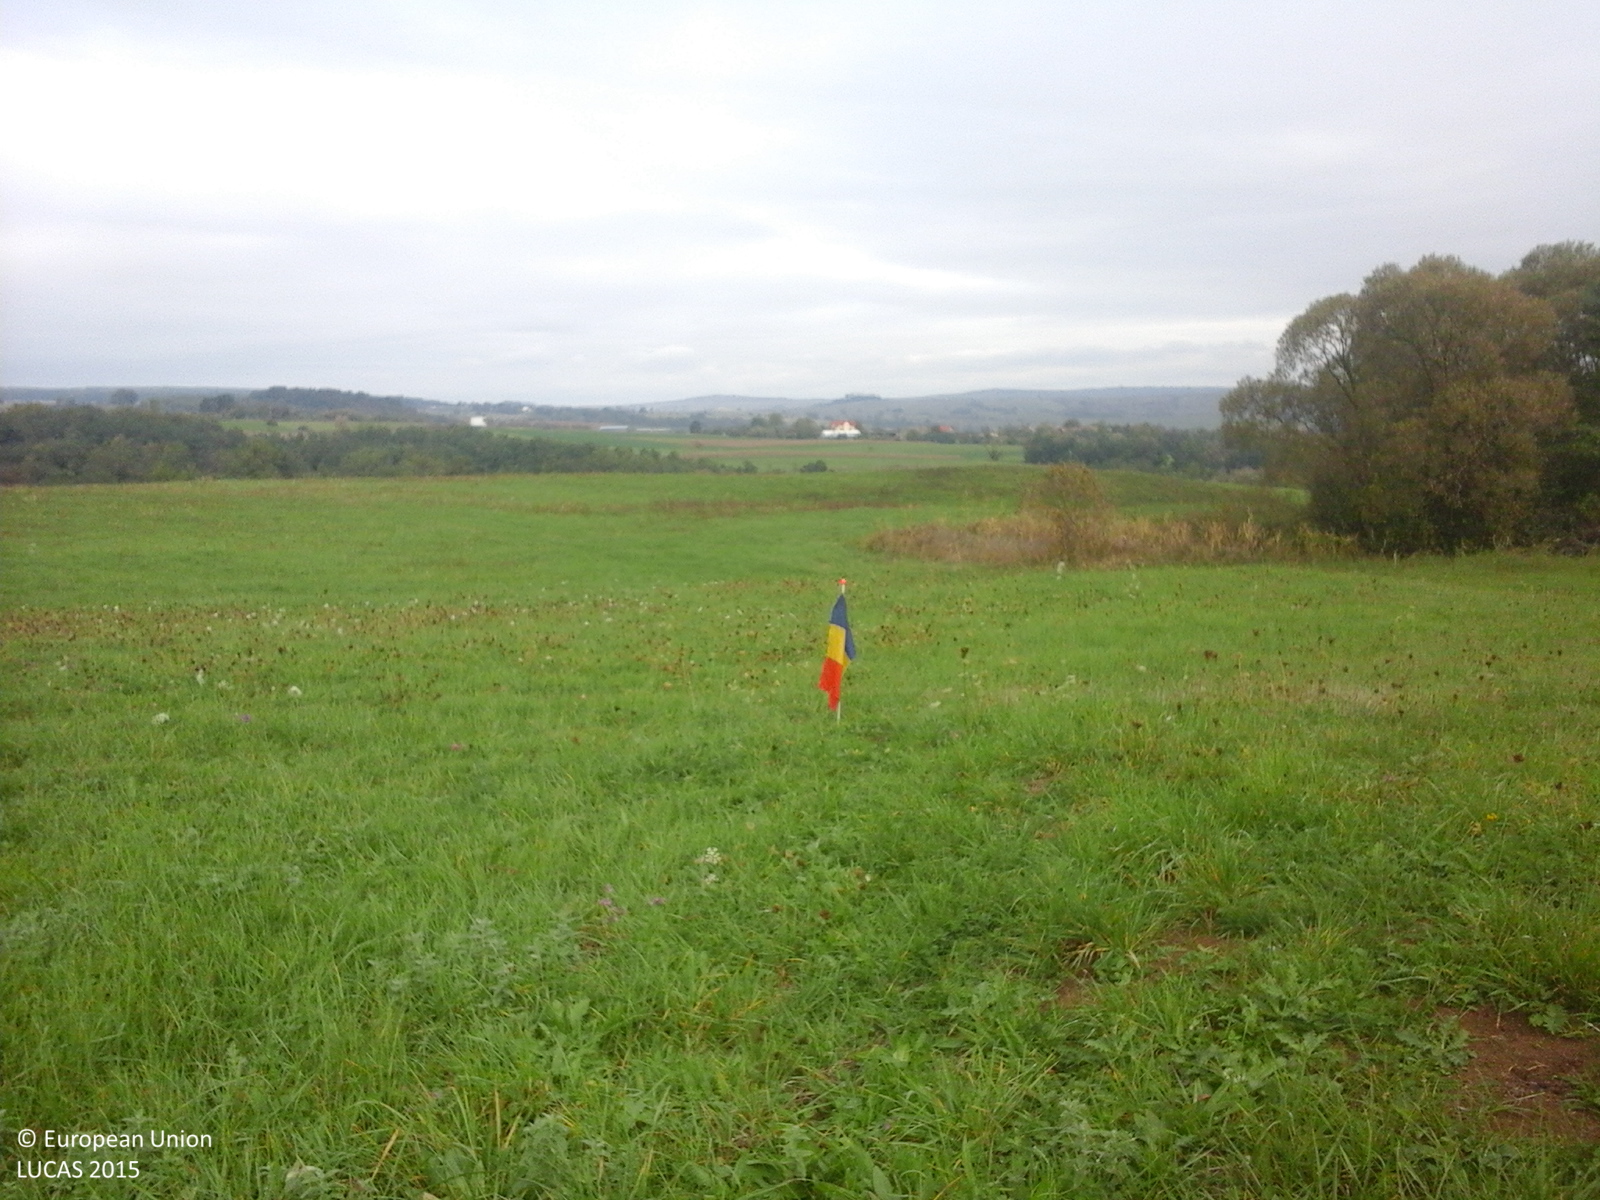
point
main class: Grassland
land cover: Grassland without tree/shrub cover
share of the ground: > 75 %
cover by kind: herbaceous plants 100 %
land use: Agriculture (excluding fallow land and kitchen gardens)
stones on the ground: < 10 %
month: October
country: RO
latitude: 45.9008
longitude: 24.7954
